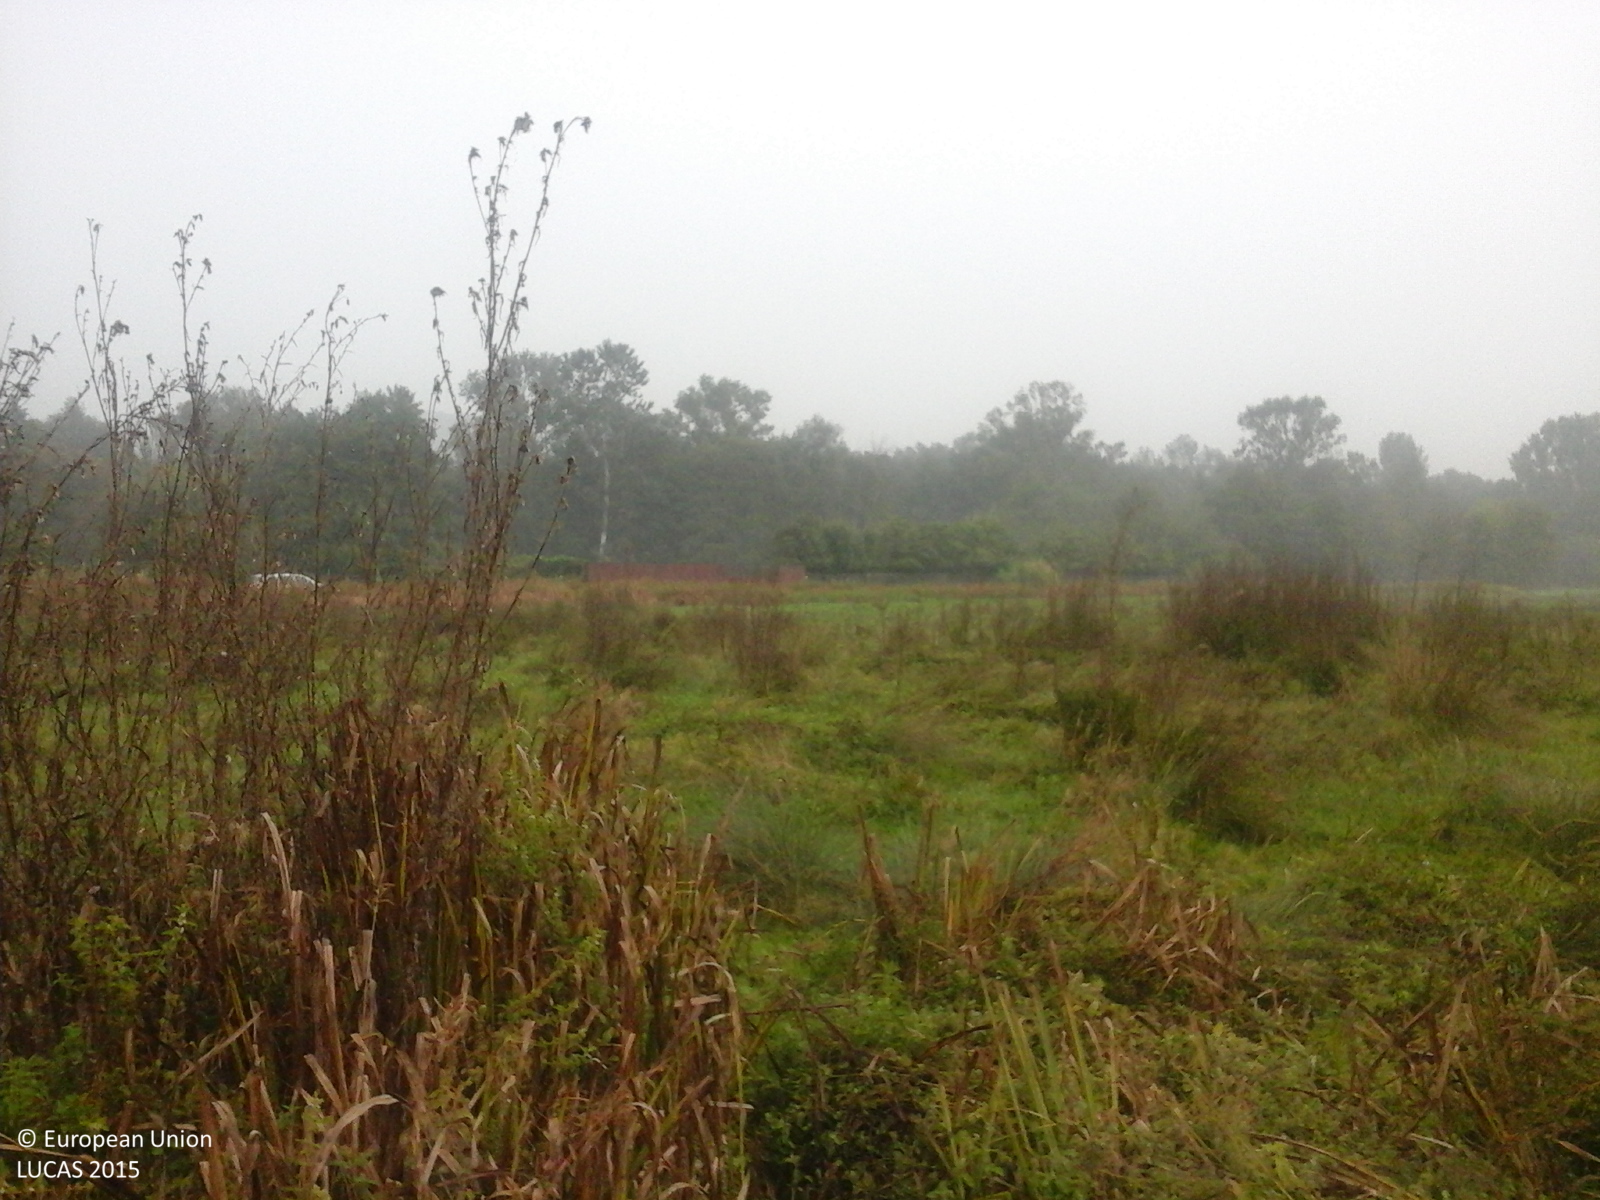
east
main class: Grassland
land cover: Spontaneously vegetated surfaces
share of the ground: > 75 %
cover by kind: herbaceous plants 100 %
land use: Agriculture (excluding fallow land and kitchen gardens)
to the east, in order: Spontaneously vegetated surfaces; Ditches and canals; Shruby margins; Tracks; Grass margins; Fences; Maize; Fences; Grassland with sparse tree/shrub cover; Broadleaved woodland; Tracks; Broadleaved woodland; Inland fresh running water; Rocks and stones; Broadleaved woodland
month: September
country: RO
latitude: 44.9480
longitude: 22.8864
